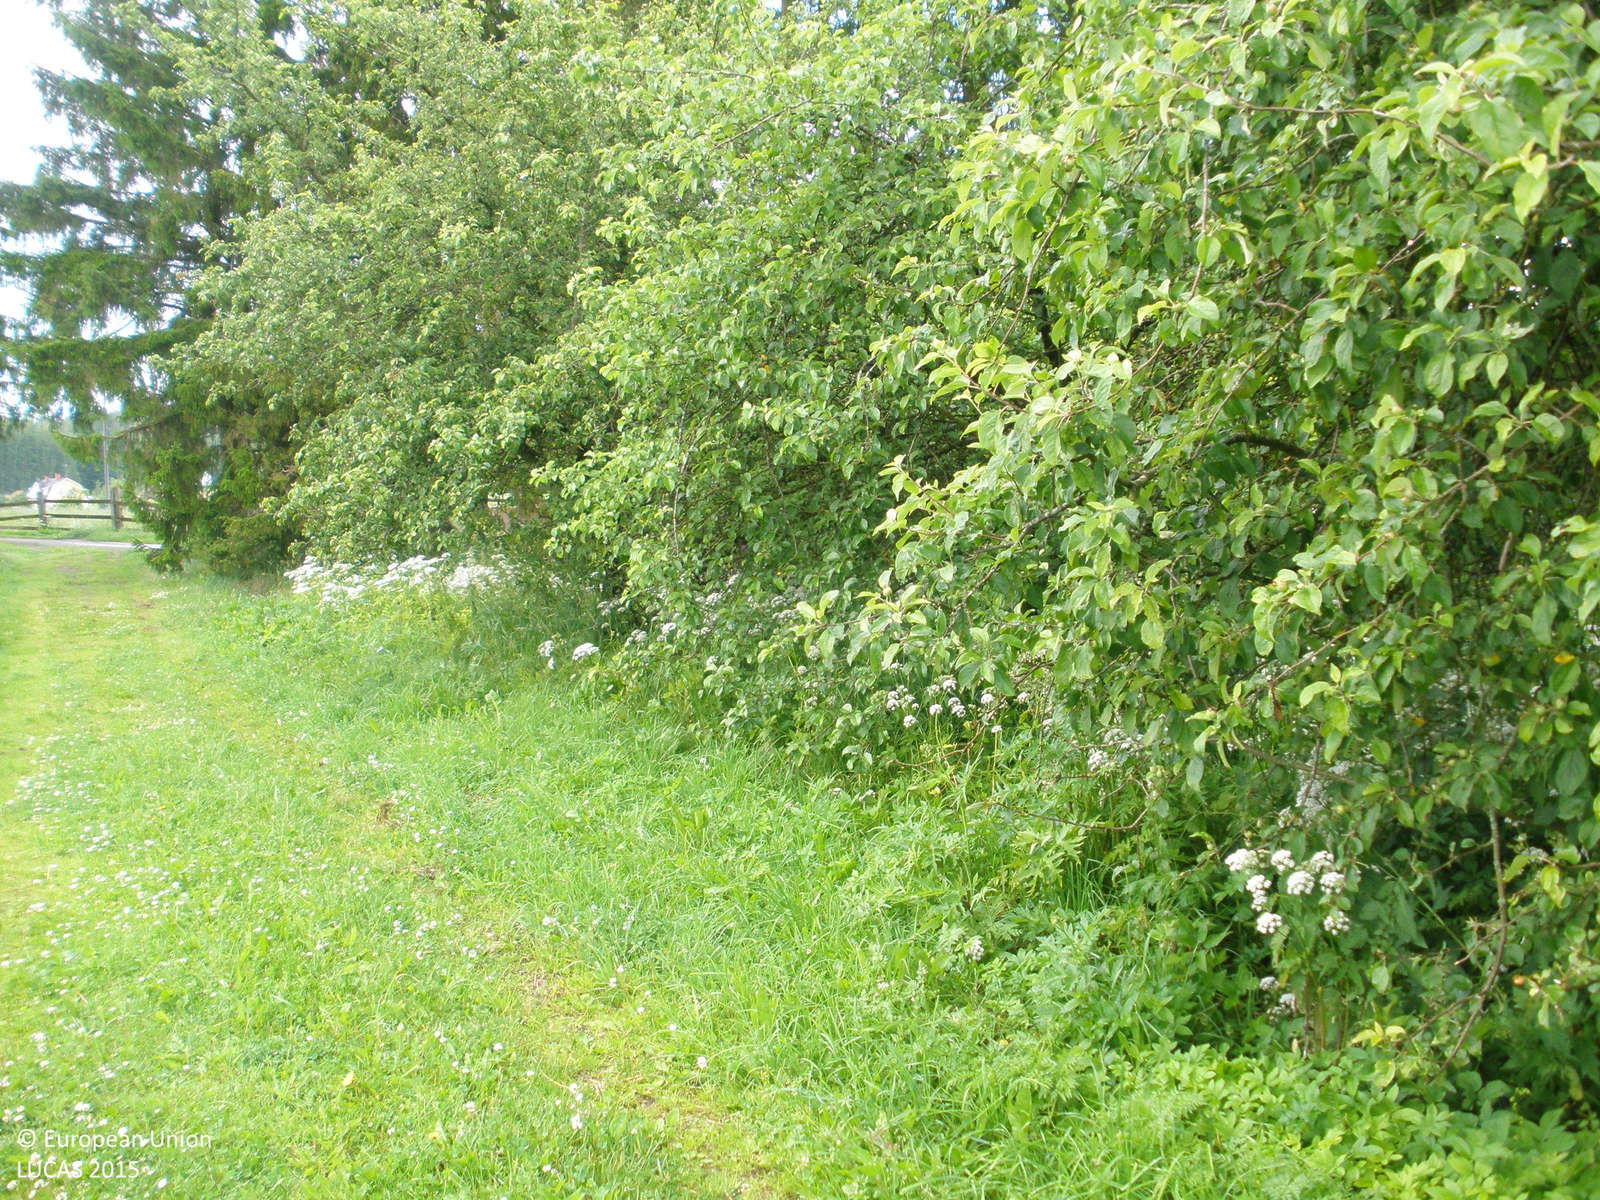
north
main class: Cropland
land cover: Temporary grasslands
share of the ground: 25 - 50 %
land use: Agriculture (excluding fallow land and kitchen gardens)
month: July
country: FI
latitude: 61.4190
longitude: 23.2485
